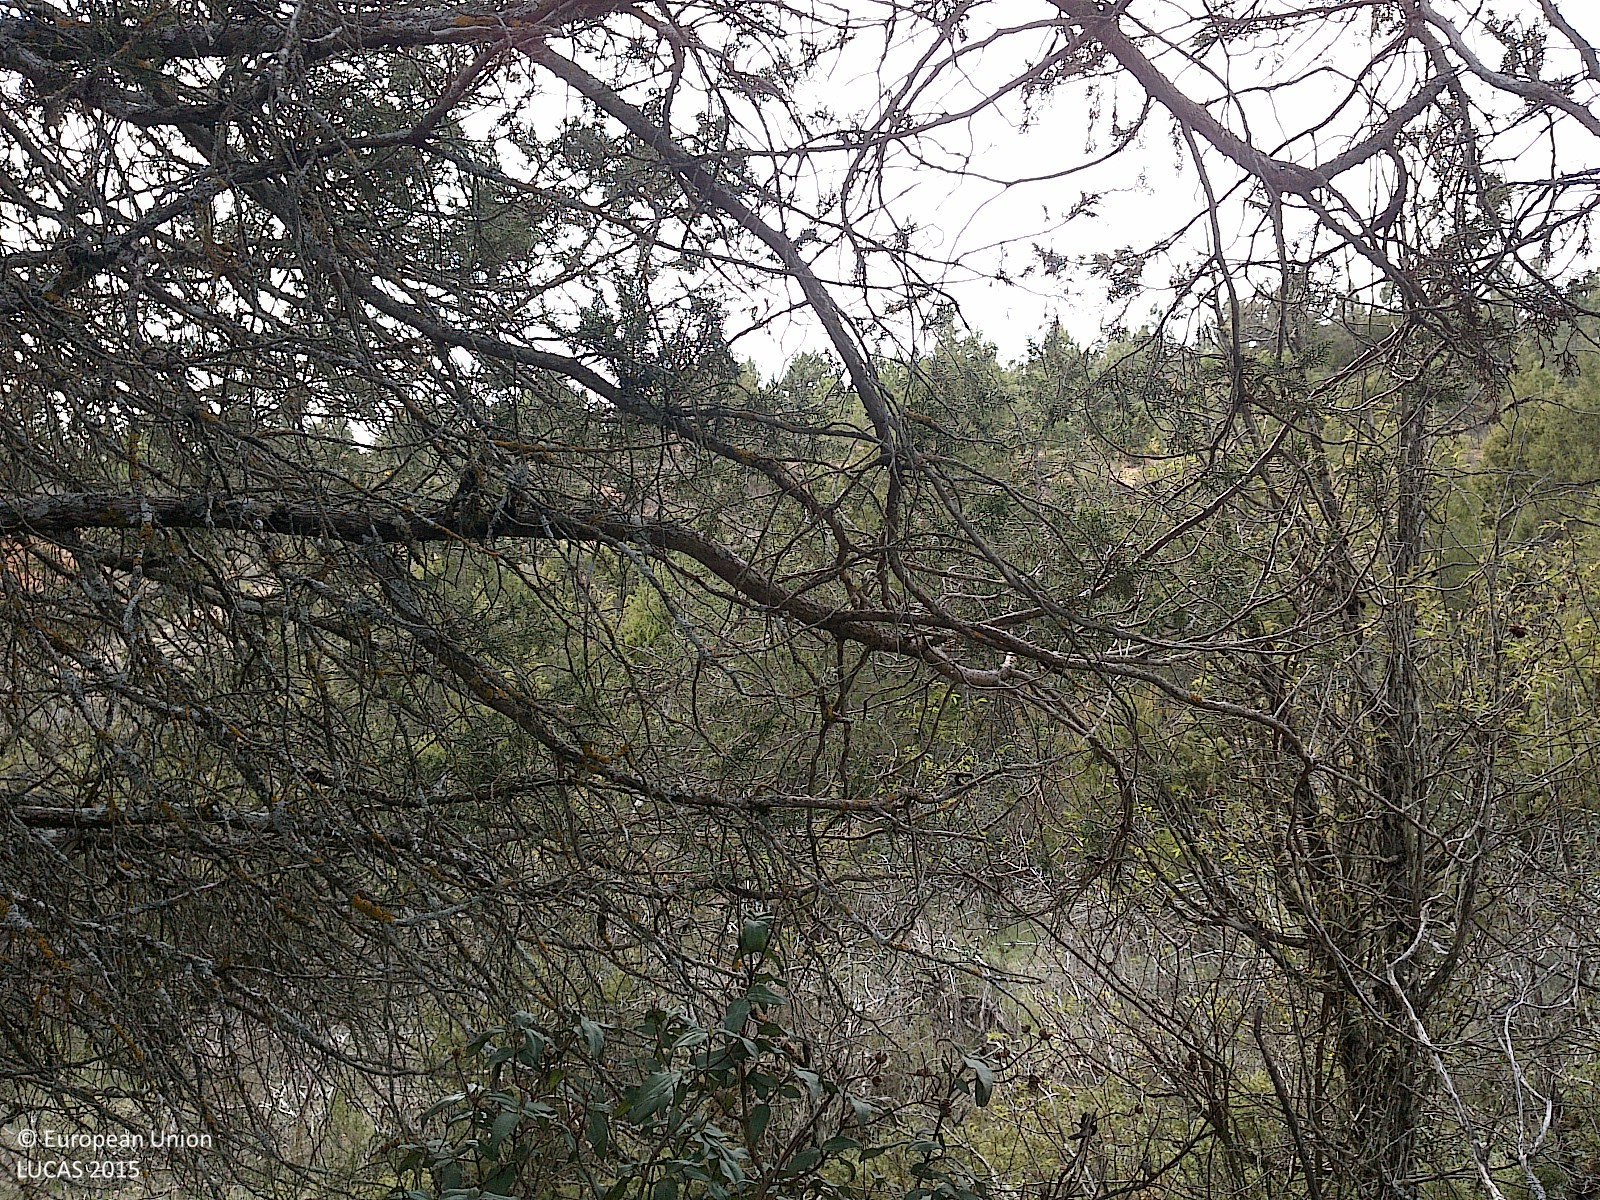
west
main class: Woodland
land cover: Other coniferous woodland
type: coniferous forest of the mediterranean region
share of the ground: 25 - 50 %
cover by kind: shrubs 65 %, coniferous forest trees 30 %, herbaceous plants 5 %
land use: Semi-natural and natural areas not in use
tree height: > 5 m
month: April
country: ES
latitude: 41.6982
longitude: -3.0336
